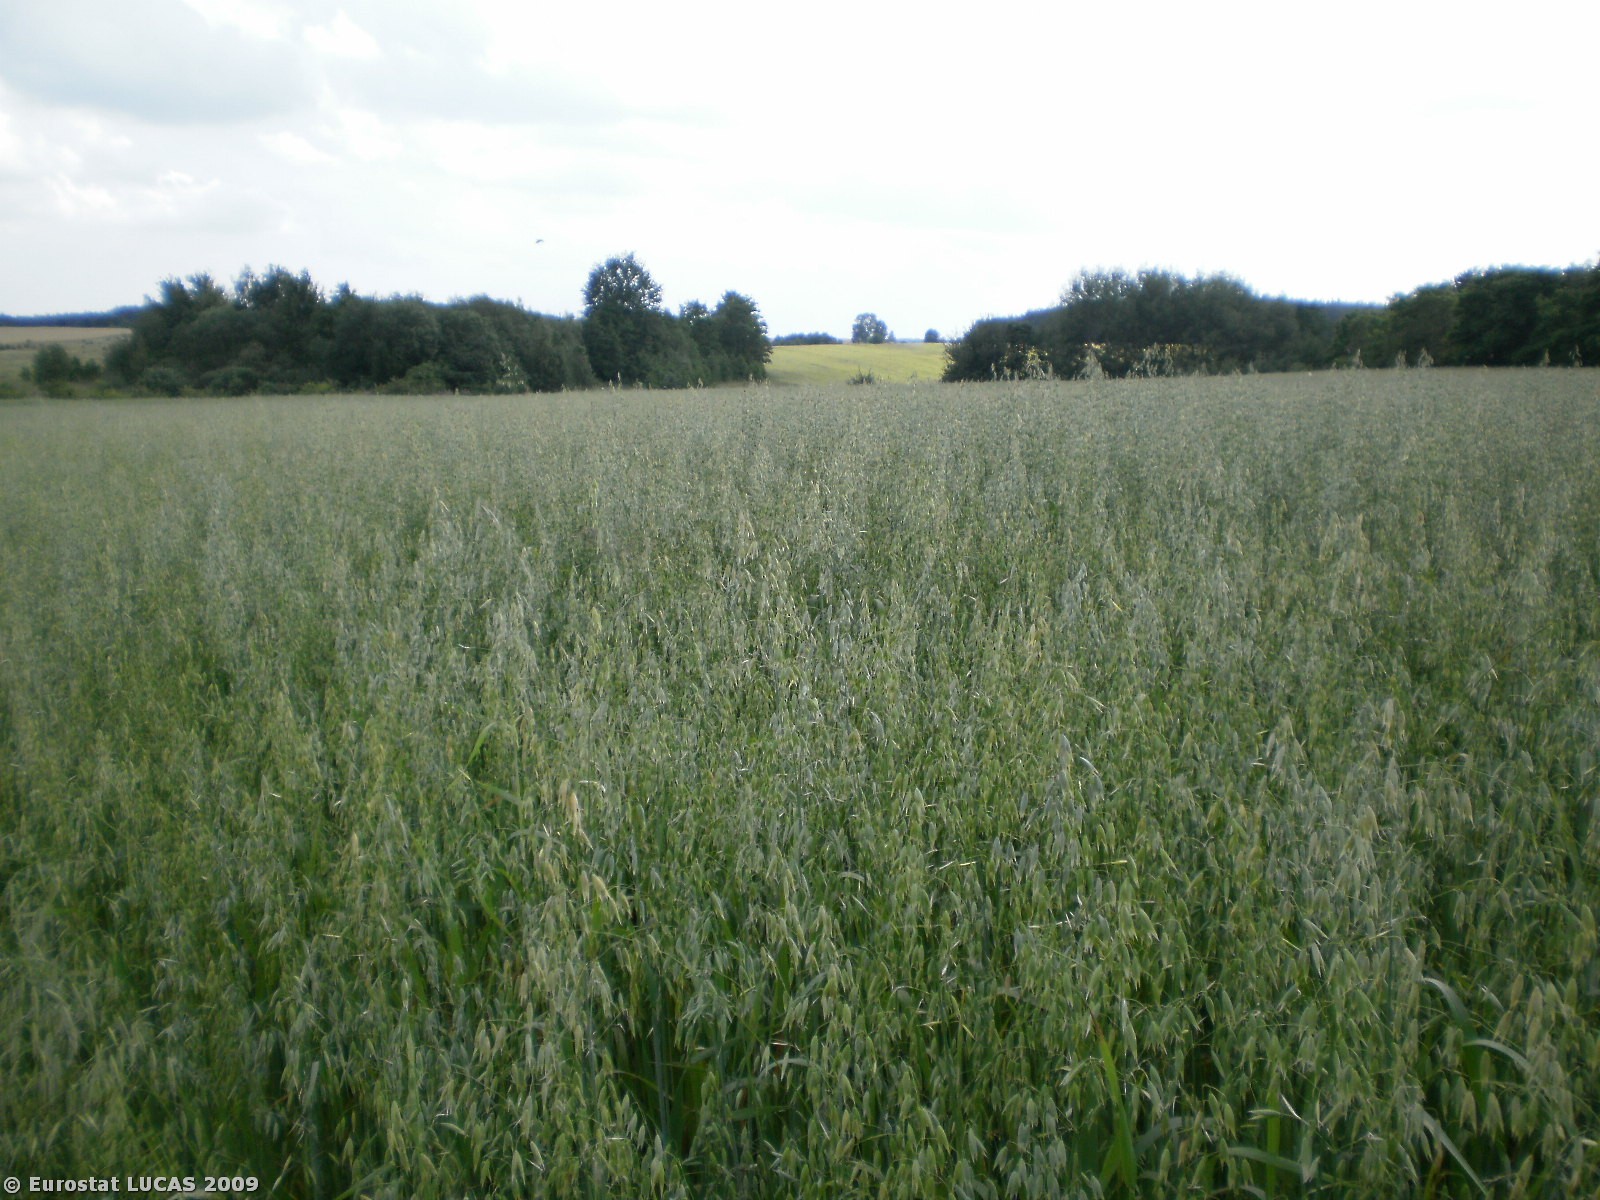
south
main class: Cropland
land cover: Oats
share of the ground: > 75 %
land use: Agriculture (excluding fallow land and kitchen gardens)
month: July
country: PL
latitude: 53.3300
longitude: 20.4424
